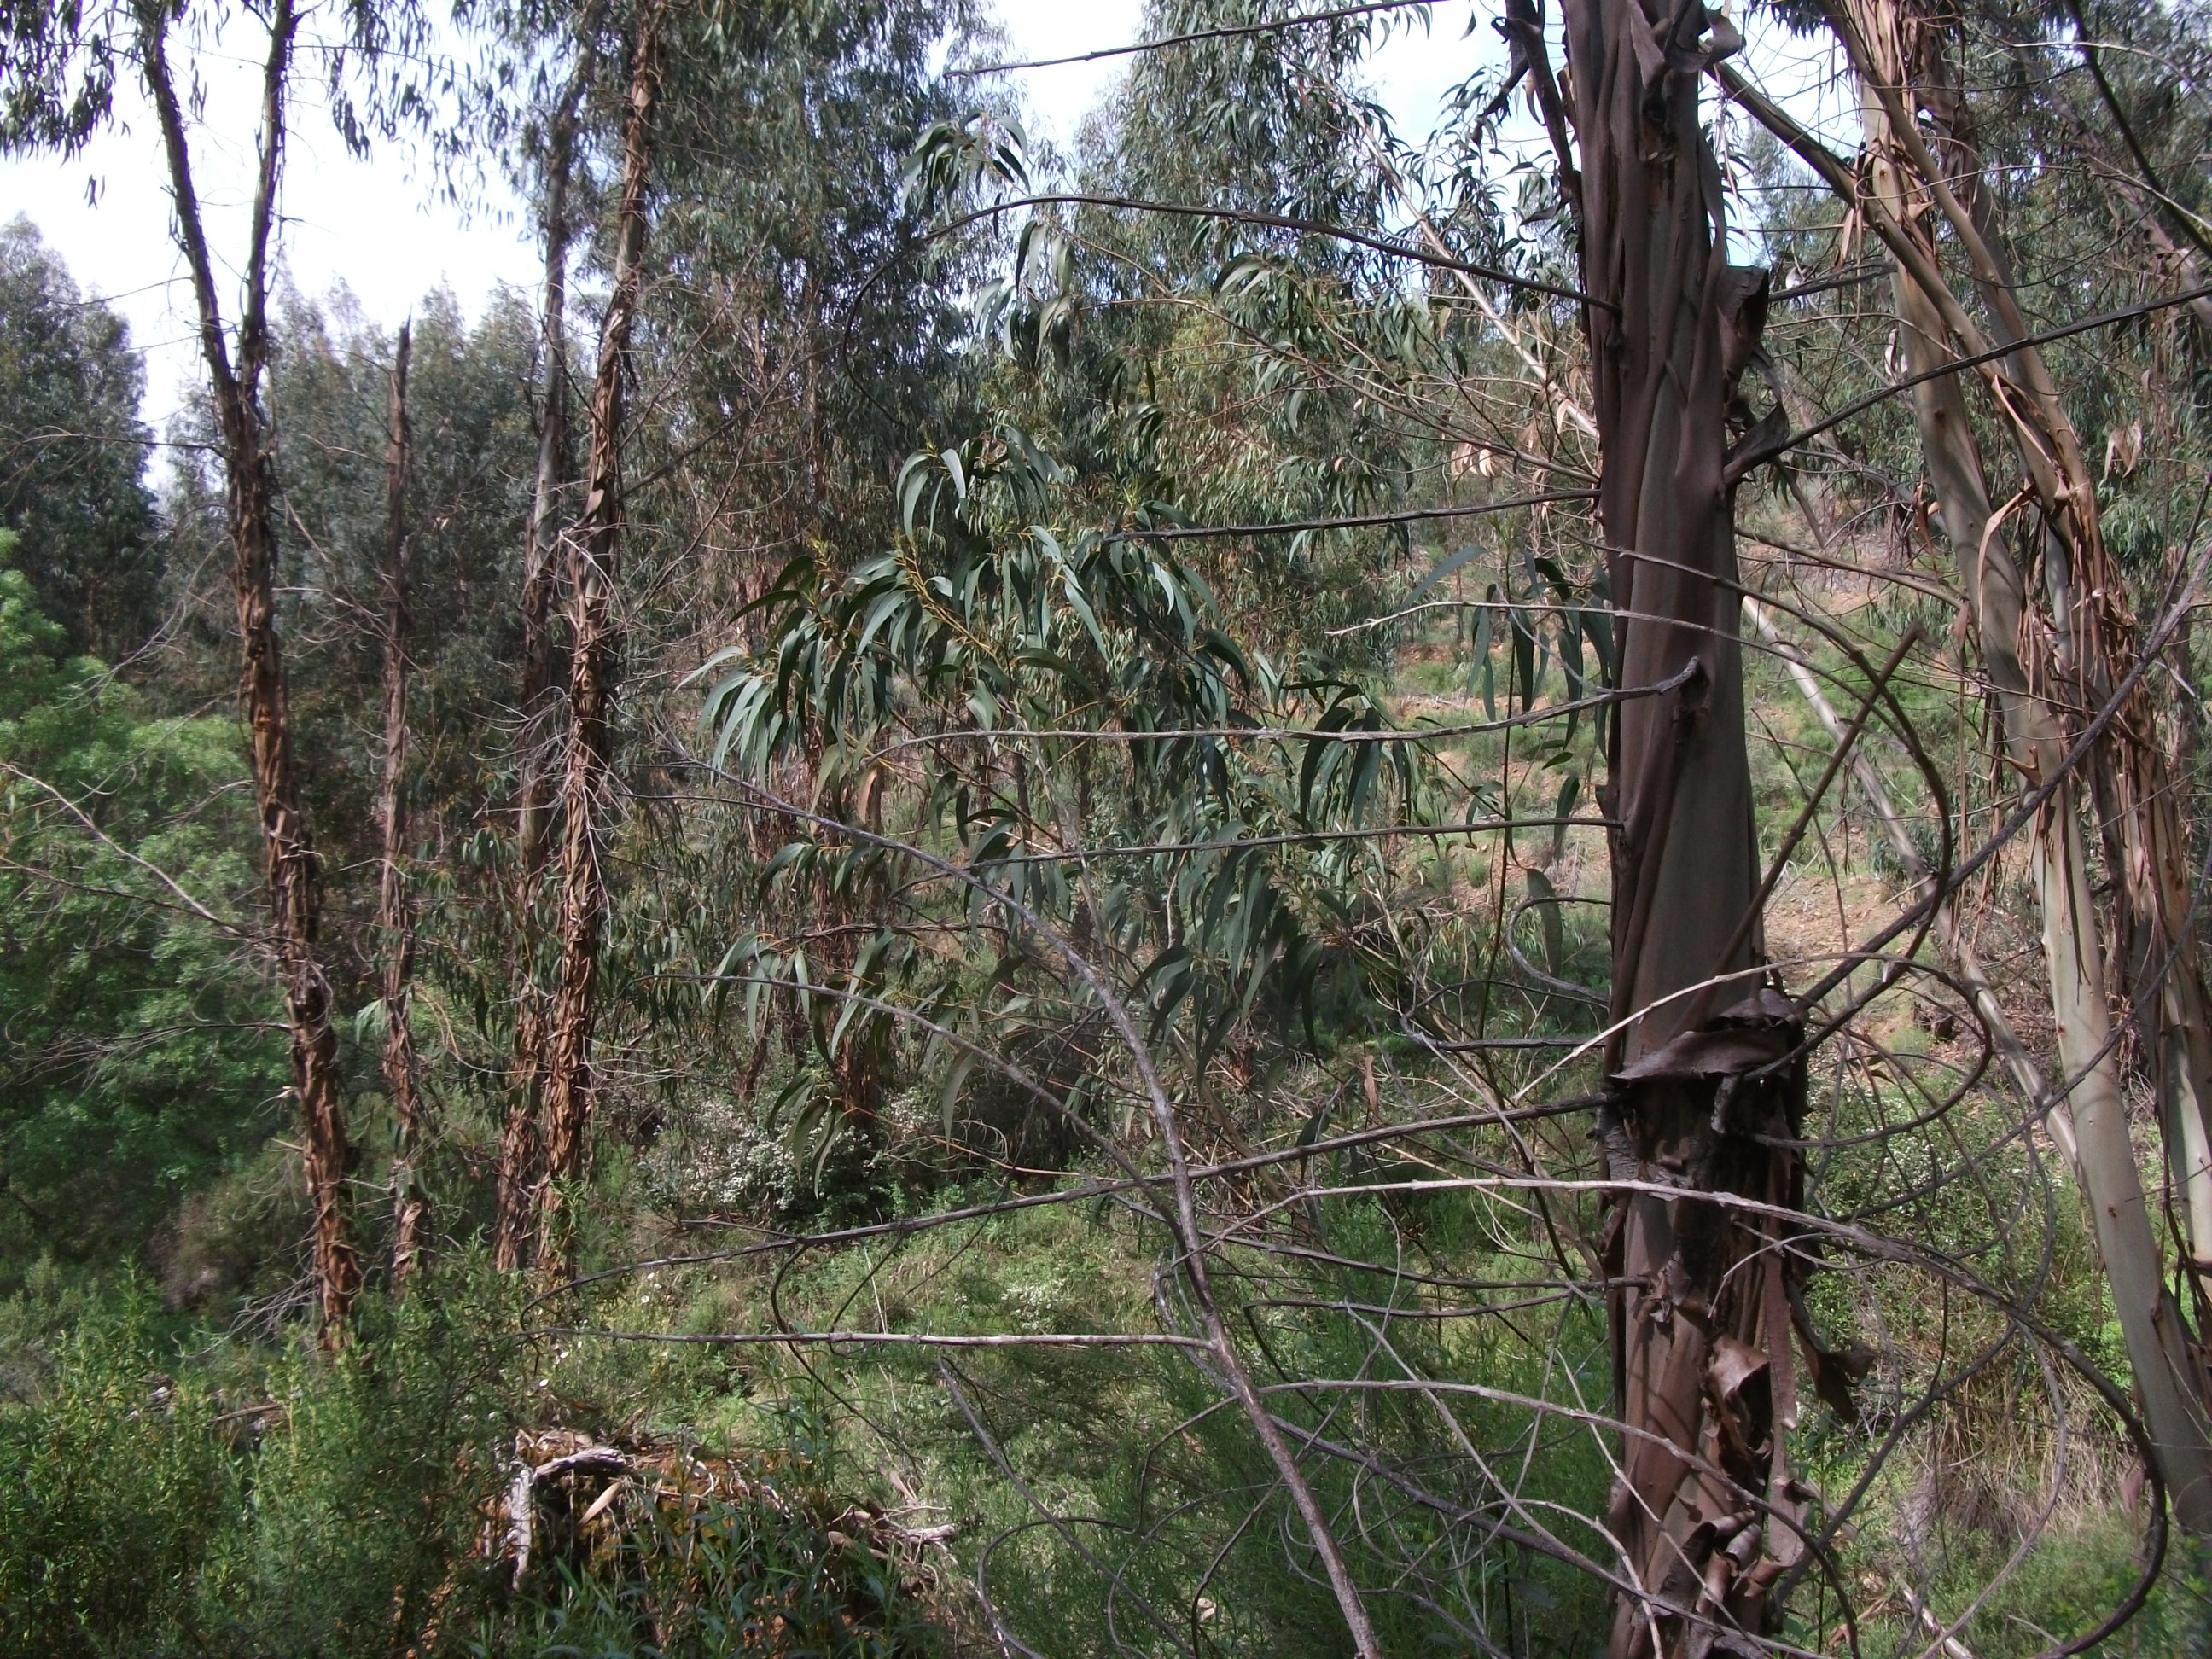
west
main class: Woodland
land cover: Broadleaved woodland
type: broadleaved evergreen forest
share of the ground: 25 - 50 %
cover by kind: shrubs 50 %, broadleaved forest trees 40 %
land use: Forestry
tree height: > 5 m
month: April
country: ES
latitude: 37.8304
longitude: -6.4812
